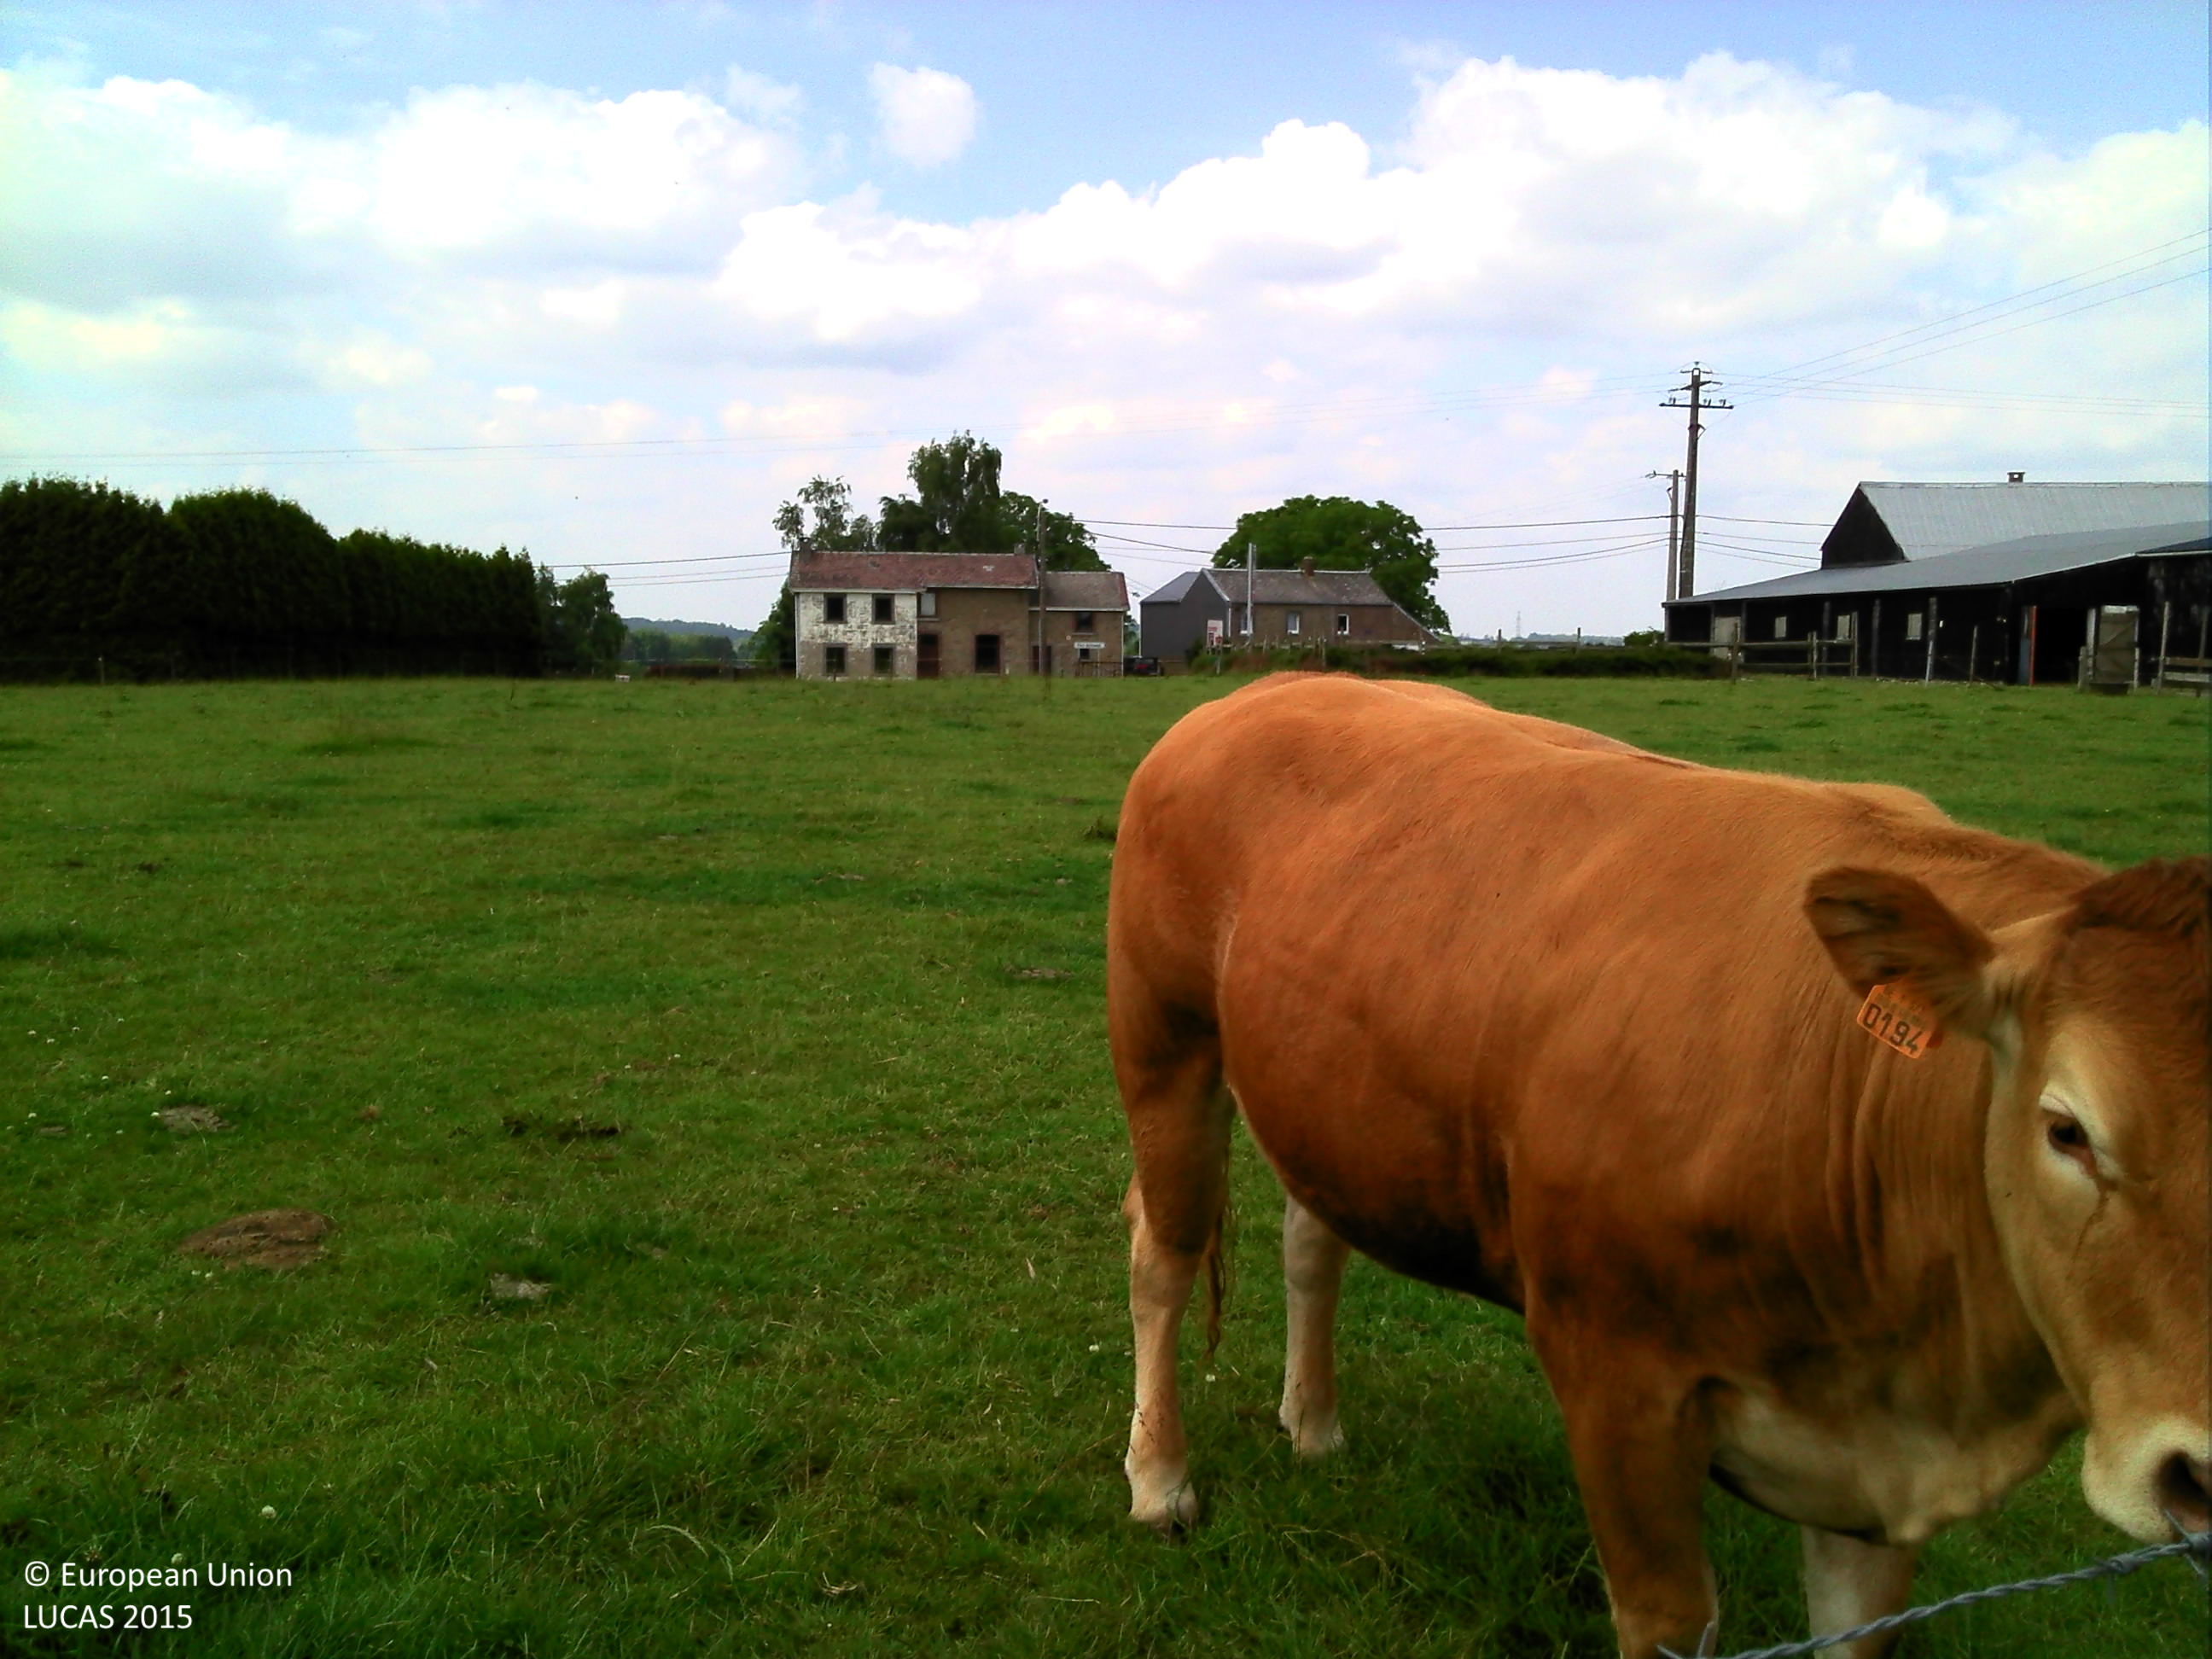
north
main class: Grassland
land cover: Grassland without tree/shrub cover
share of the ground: > 75 %
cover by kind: herbaceous plants 100 %
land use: Agriculture (excluding fallow land and kitchen gardens)
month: June
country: BE
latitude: 50.4368
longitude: 5.4787
